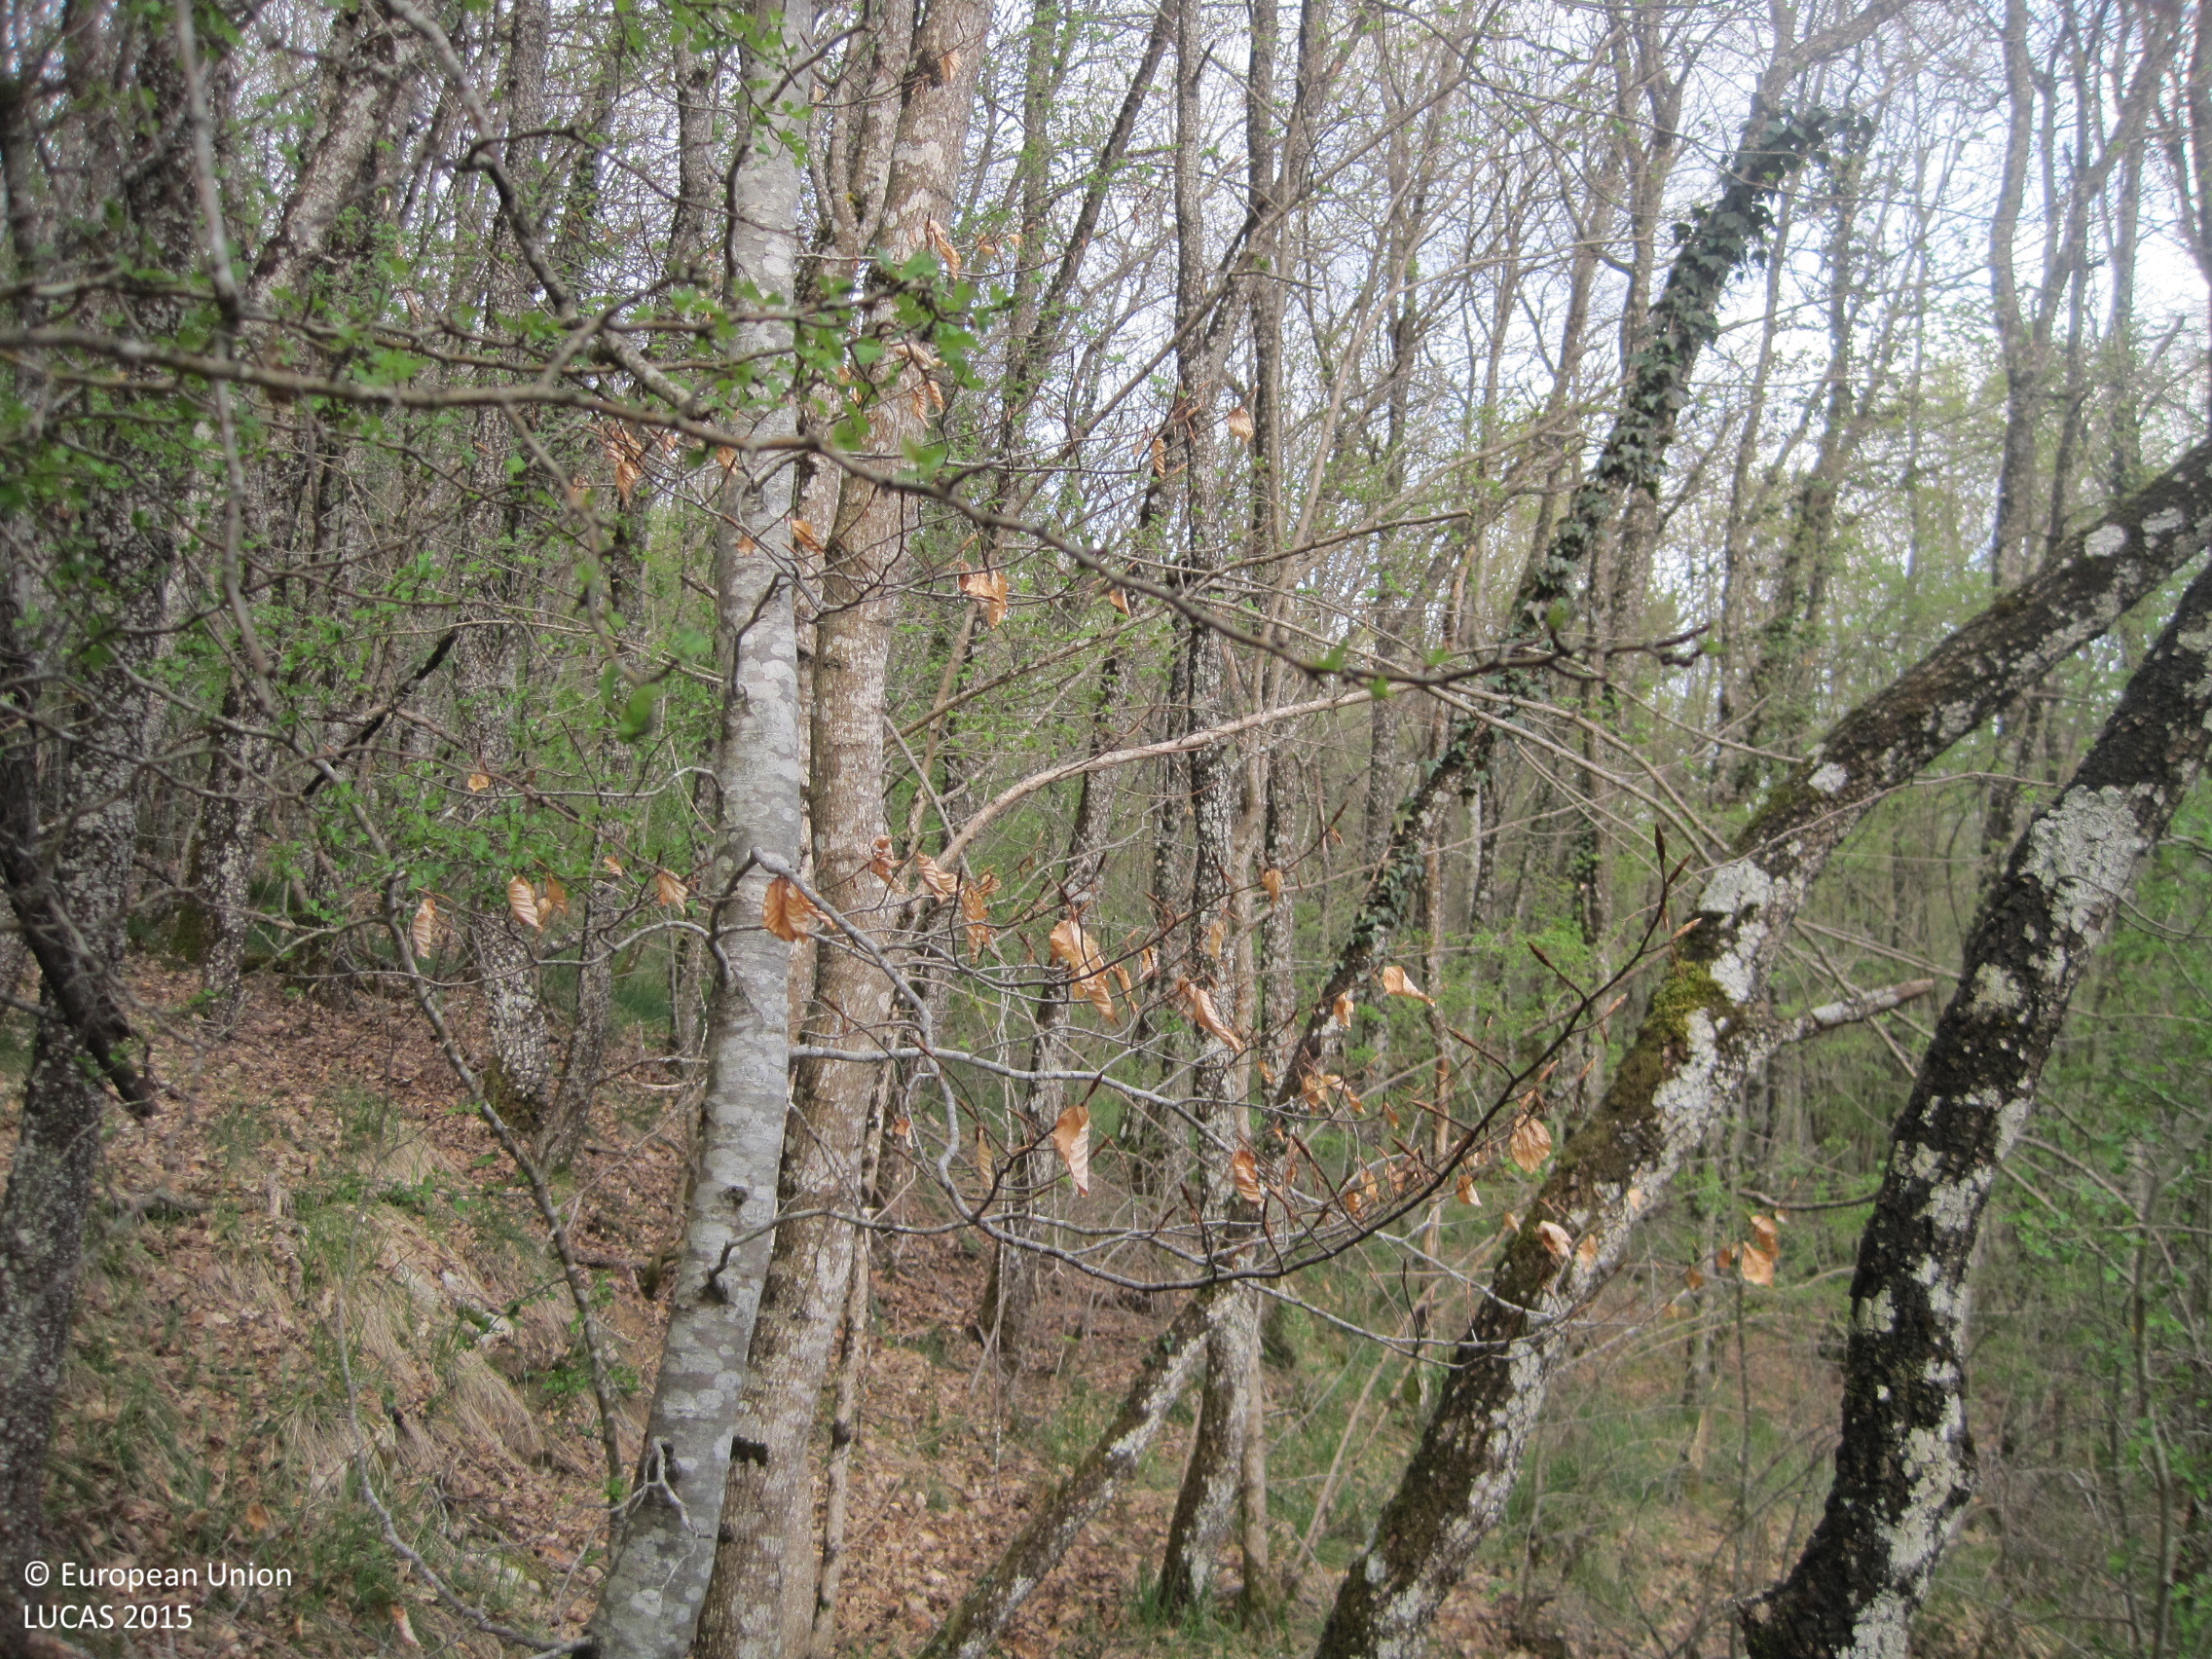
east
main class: Woodland
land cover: Broadleaved woodland
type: acidophilous oak and oak-birch forest
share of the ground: > 75 %
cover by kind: broadleaved forest trees 100 %
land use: Forestry
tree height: > 5 m
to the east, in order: Broadleaved woodland
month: April
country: ES
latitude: 42.7732
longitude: -2.1809
